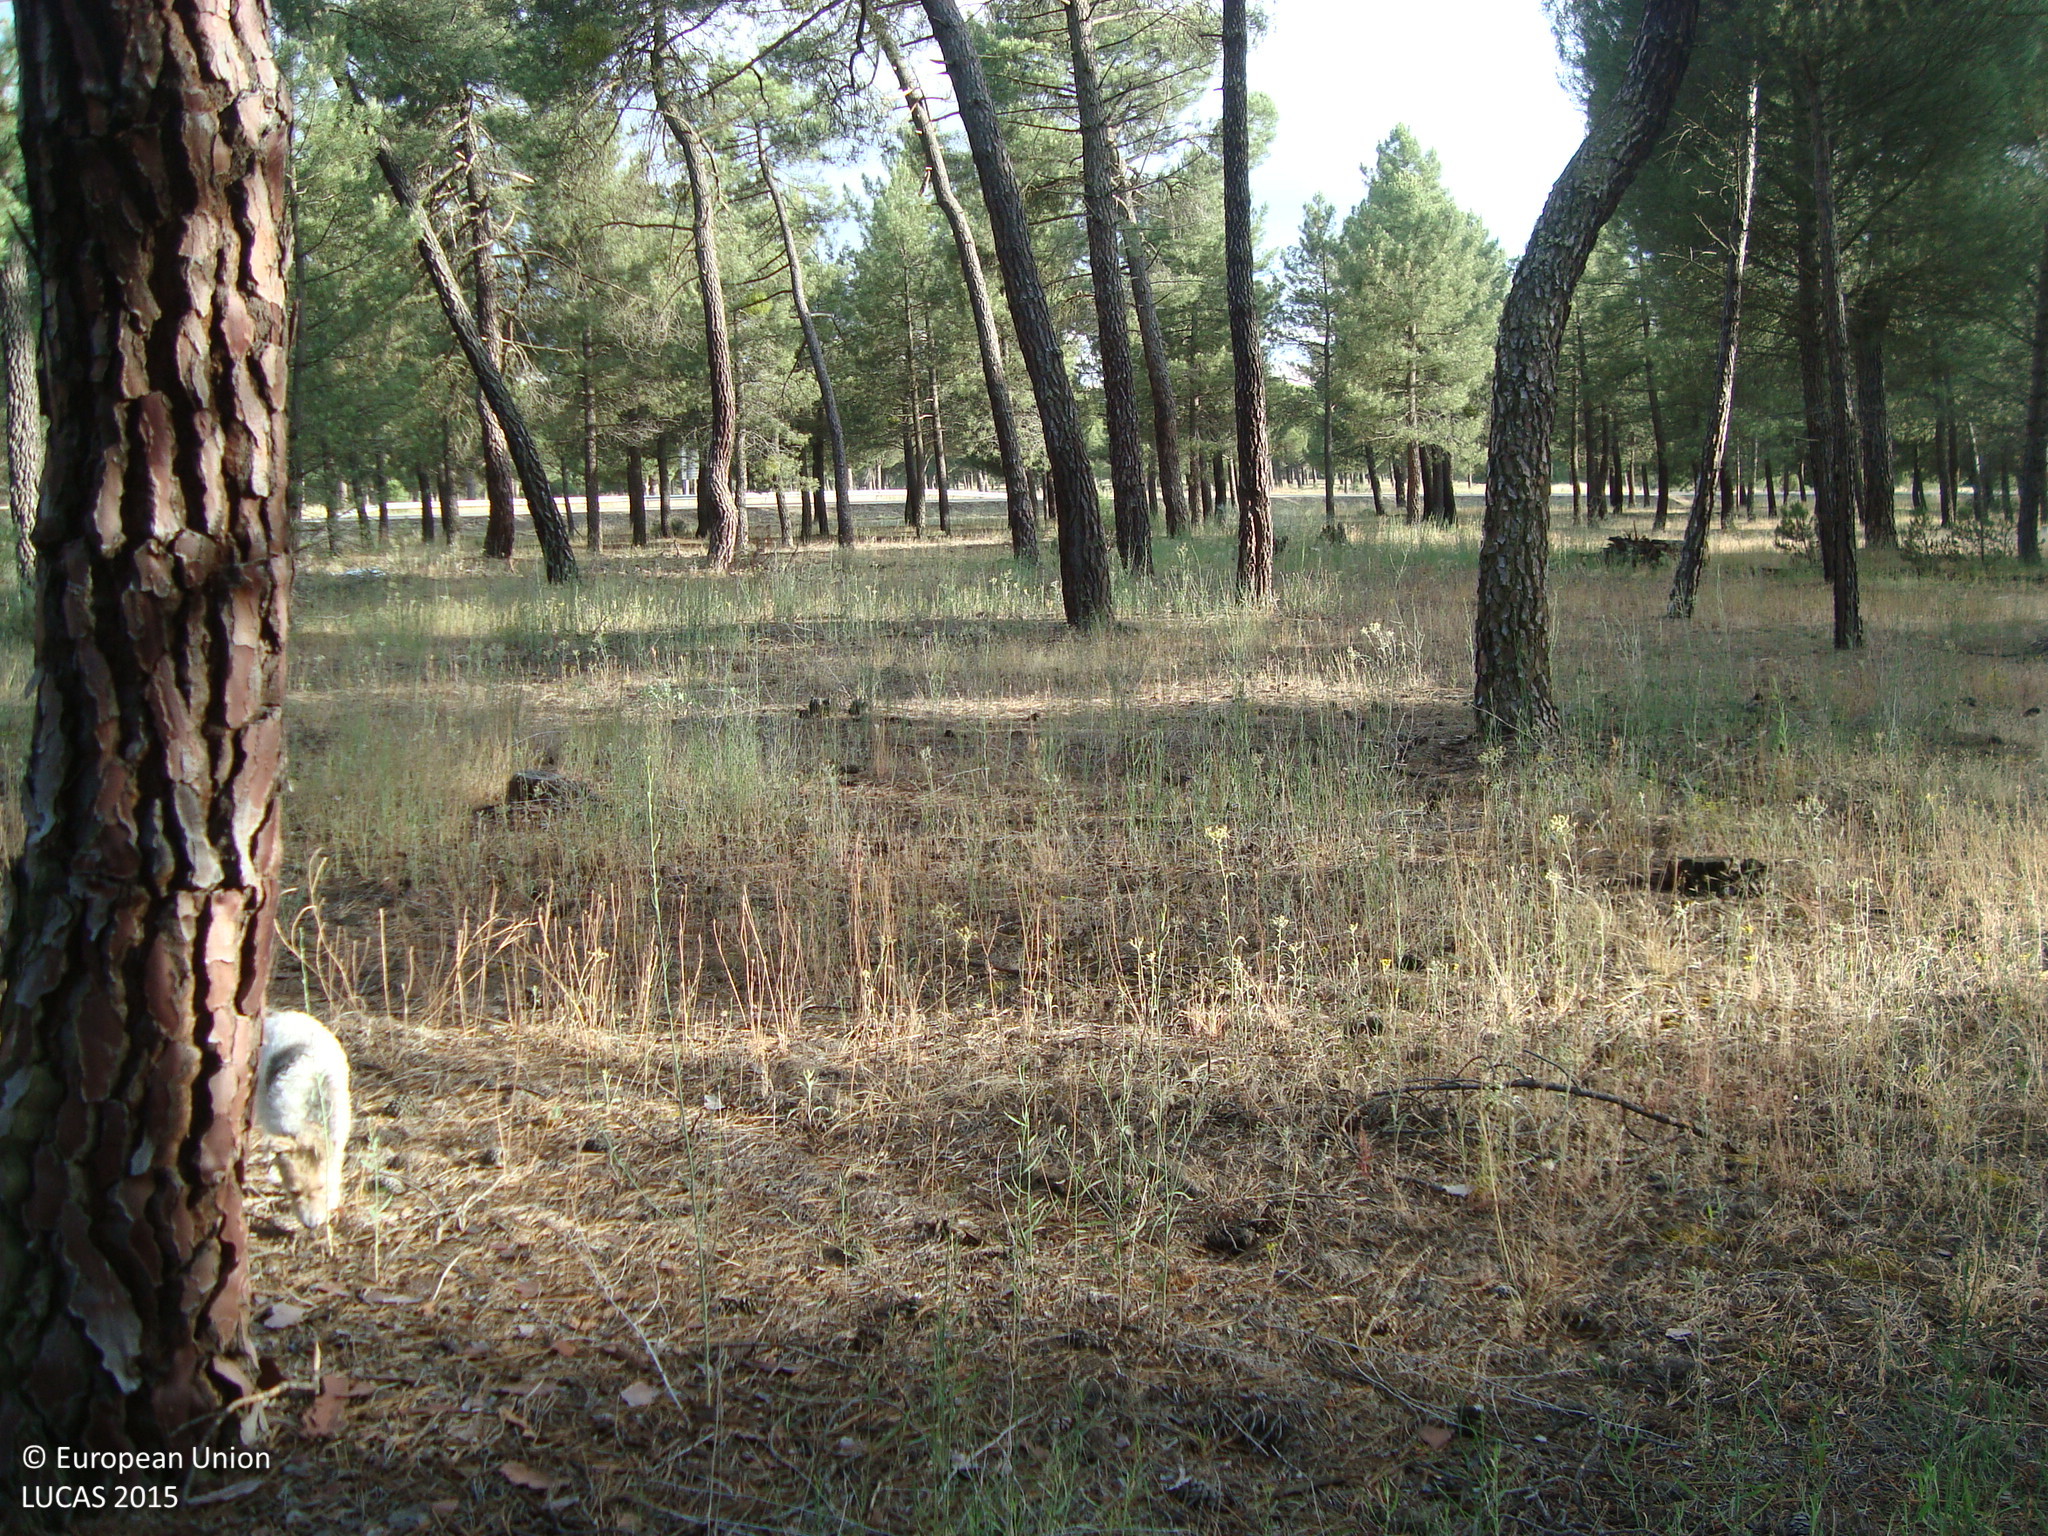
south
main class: Woodland
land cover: Pine dominated coniferous woodland
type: coniferous forest of the mediterranean region
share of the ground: > 75 %
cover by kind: coniferous forest trees 75 %, herbaceous plants 25 %
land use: Forestry
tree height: > 5 m
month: June
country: ES
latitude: 41.3323
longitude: -4.6045
